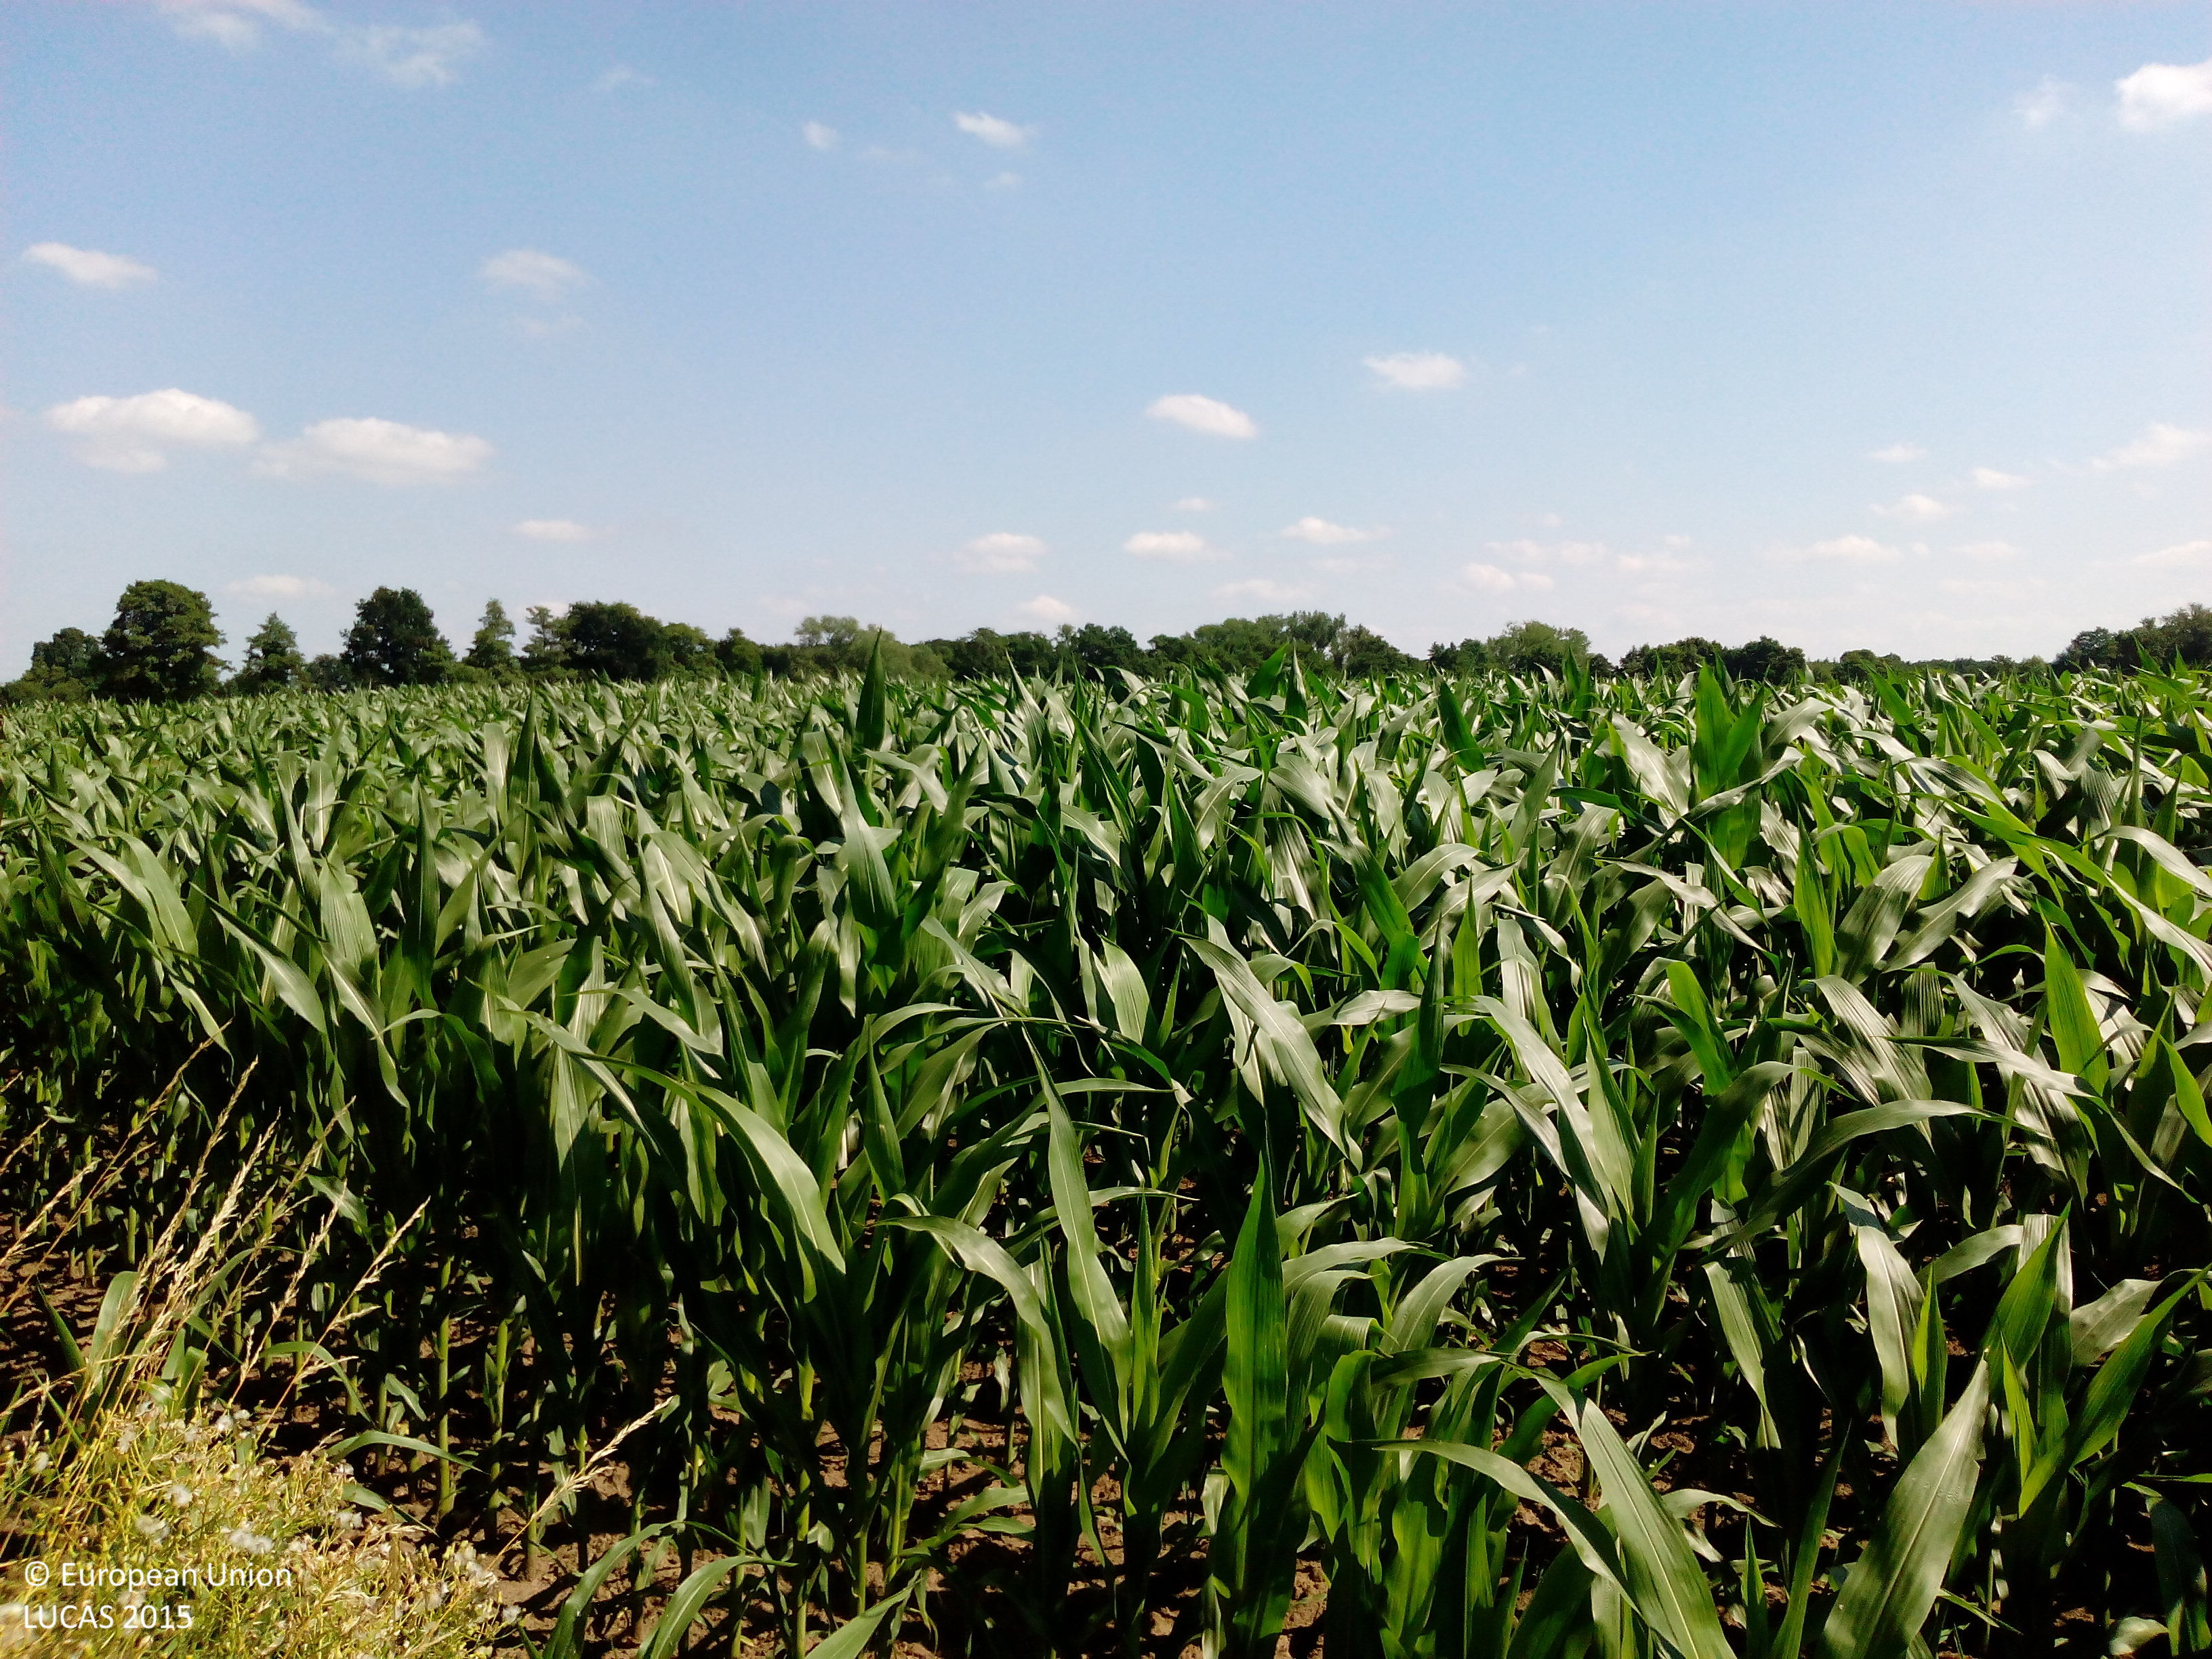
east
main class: Cropland
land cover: Maize
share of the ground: > 75 %
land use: Agriculture (excluding fallow land and kitchen gardens)
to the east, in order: Maize; Grassland without tree/shrub cover; Broadleaved woodland; Rivers and streams; Grassland without tree/shrub cover; Maize
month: July
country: DE
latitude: 52.4687
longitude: 8.0132
